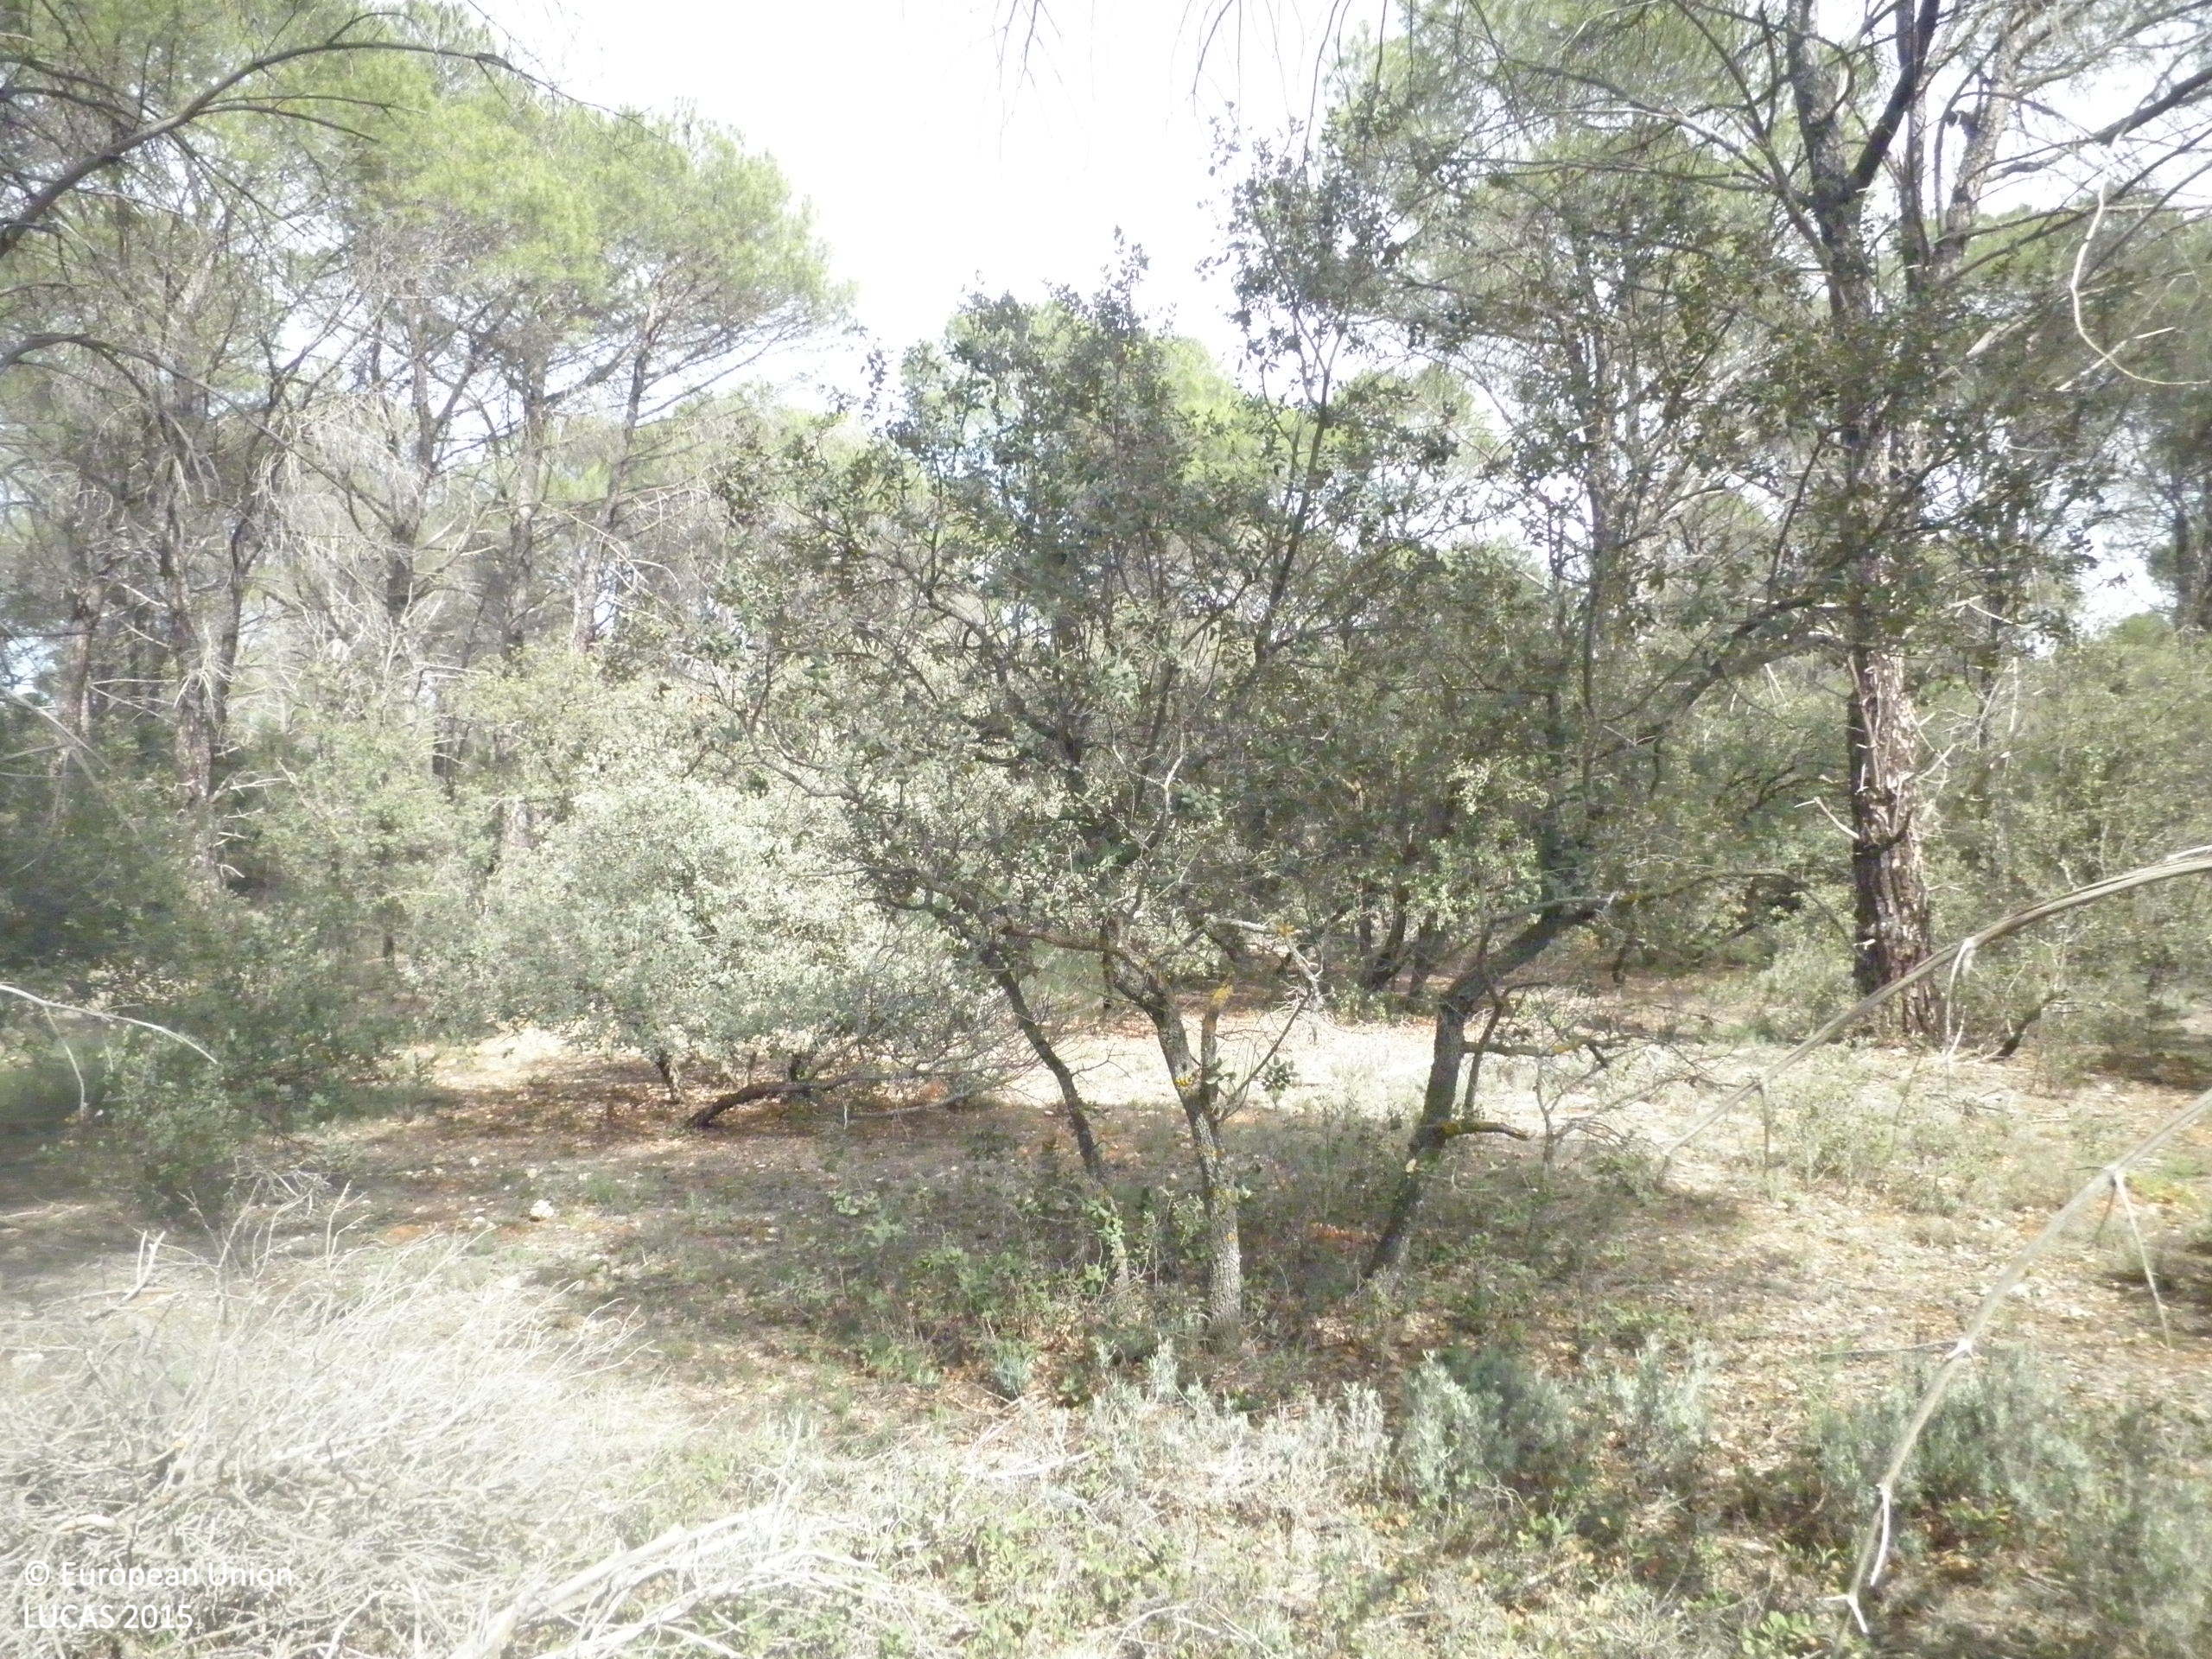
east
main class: Woodland
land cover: Pine dominated mixed woodland
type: coniferous forest of the mediterranean region
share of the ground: > 75 %
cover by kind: coniferous forest trees 45 %, broadleaved forest trees 25 %, shrubs 10 %, herbaceous plants 10 %, unconsolidated bare surface 10 %
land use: Semi-natural and natural areas not in use
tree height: > 5 m
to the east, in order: Pine dominated mixed woodland
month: April
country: ES
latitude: 39.3714
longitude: -2.6526
